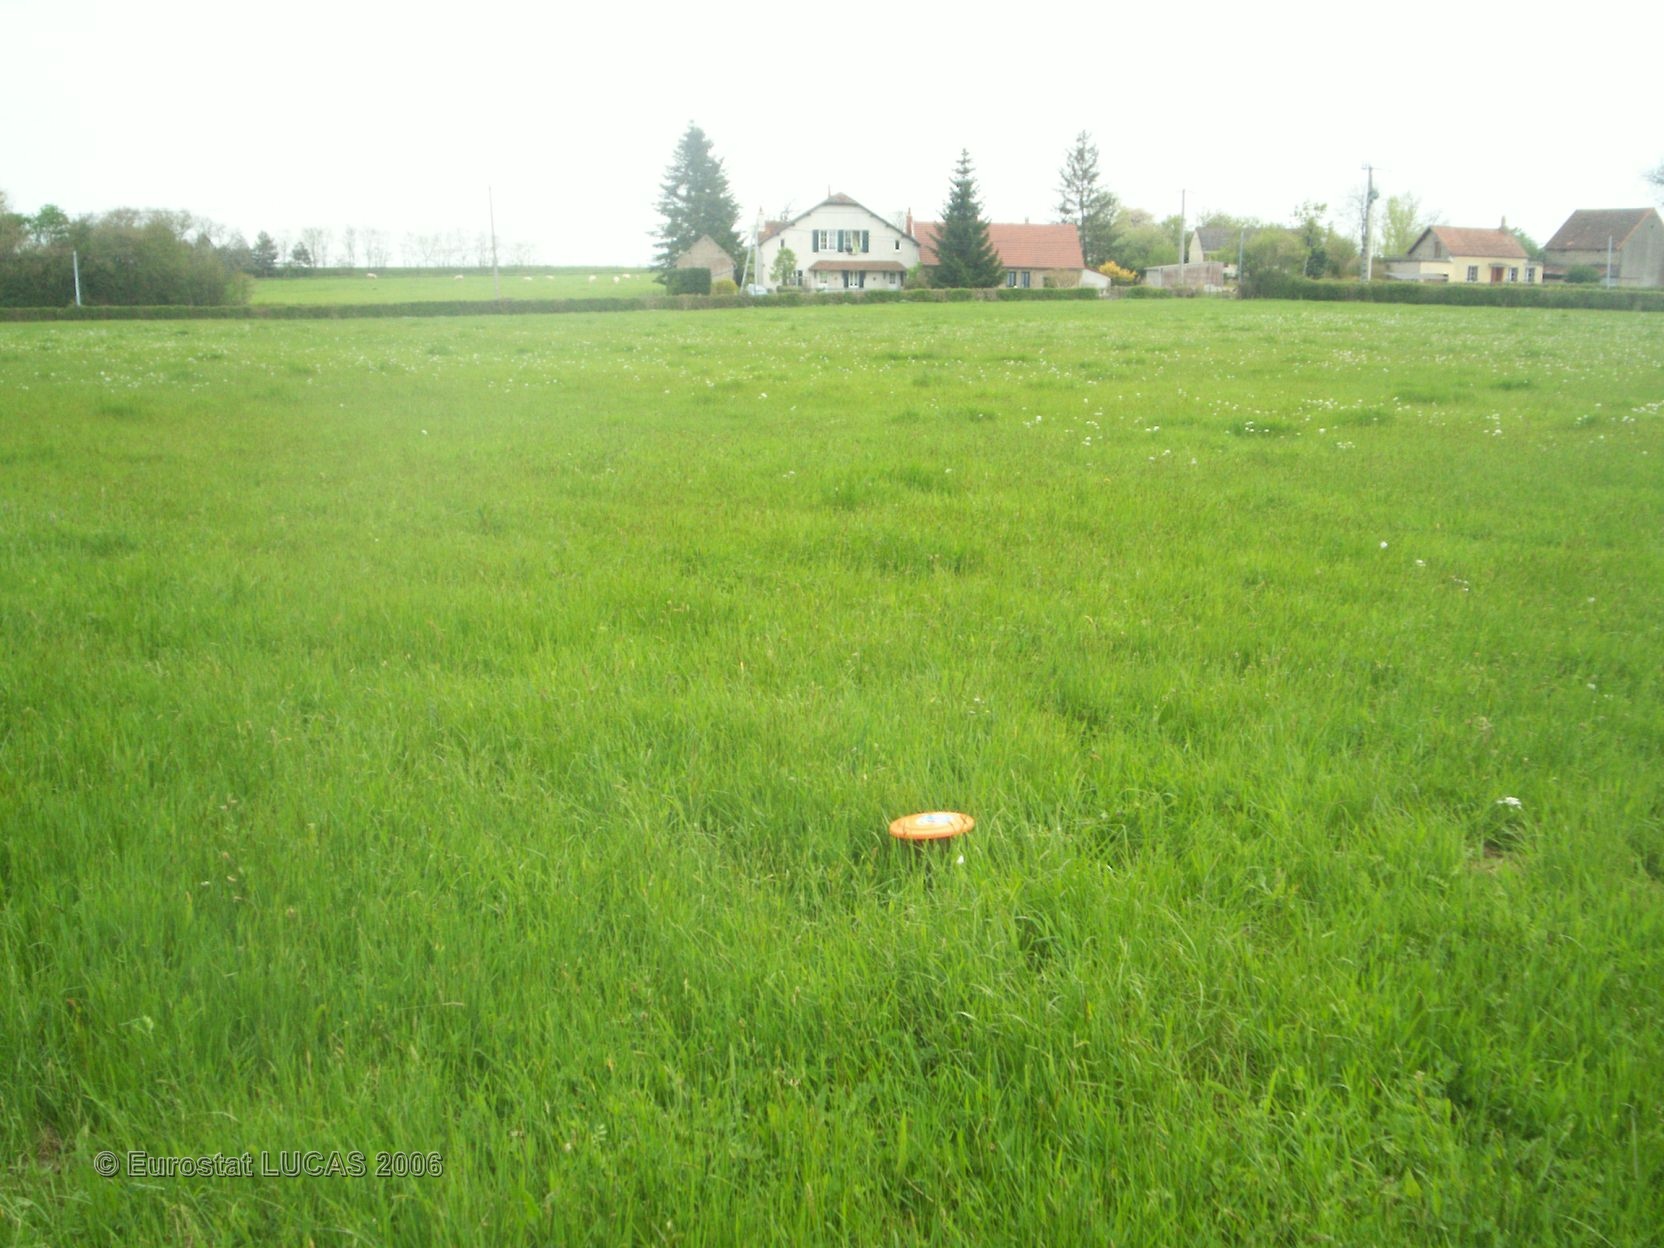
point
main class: Grassland
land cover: Grassland without tree/shrub cover
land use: Agriculture (excluding fallow land and kitchen gardens)
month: May
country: FR
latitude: 46.4380
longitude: 3.1387
